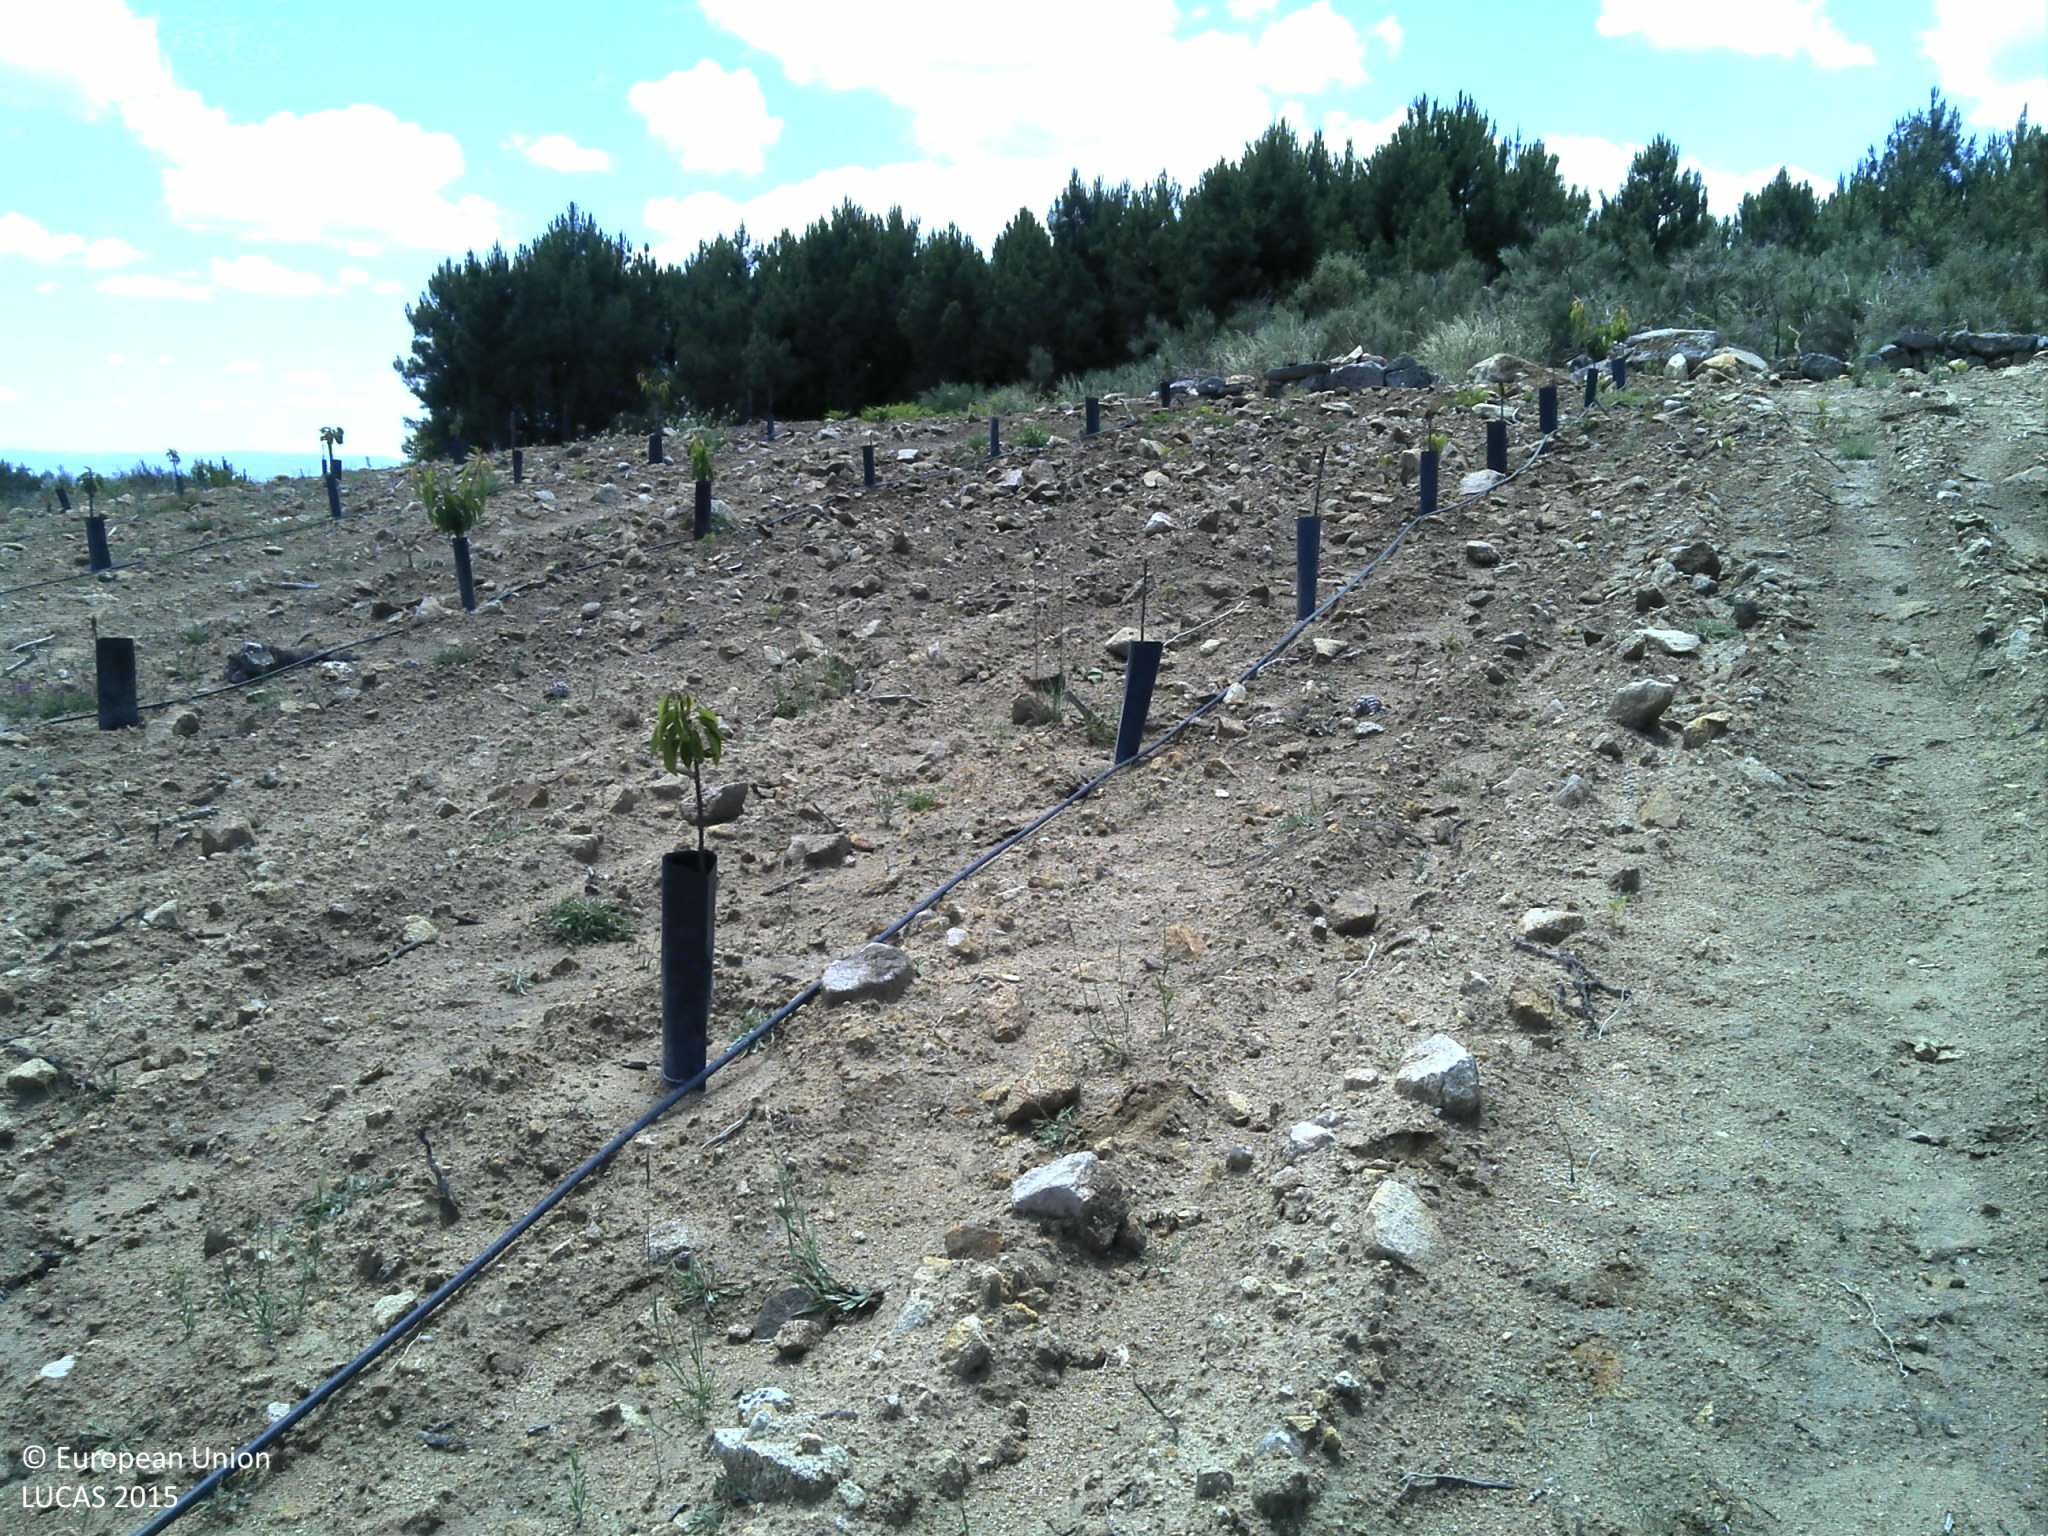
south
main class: Cropland
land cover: Cherry fruit
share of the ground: < 10 %
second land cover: Other bare soil
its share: > 75 %
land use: Agriculture (excluding fallow land and kitchen gardens)
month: June
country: PT
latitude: 41.0526
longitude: -7.6497
